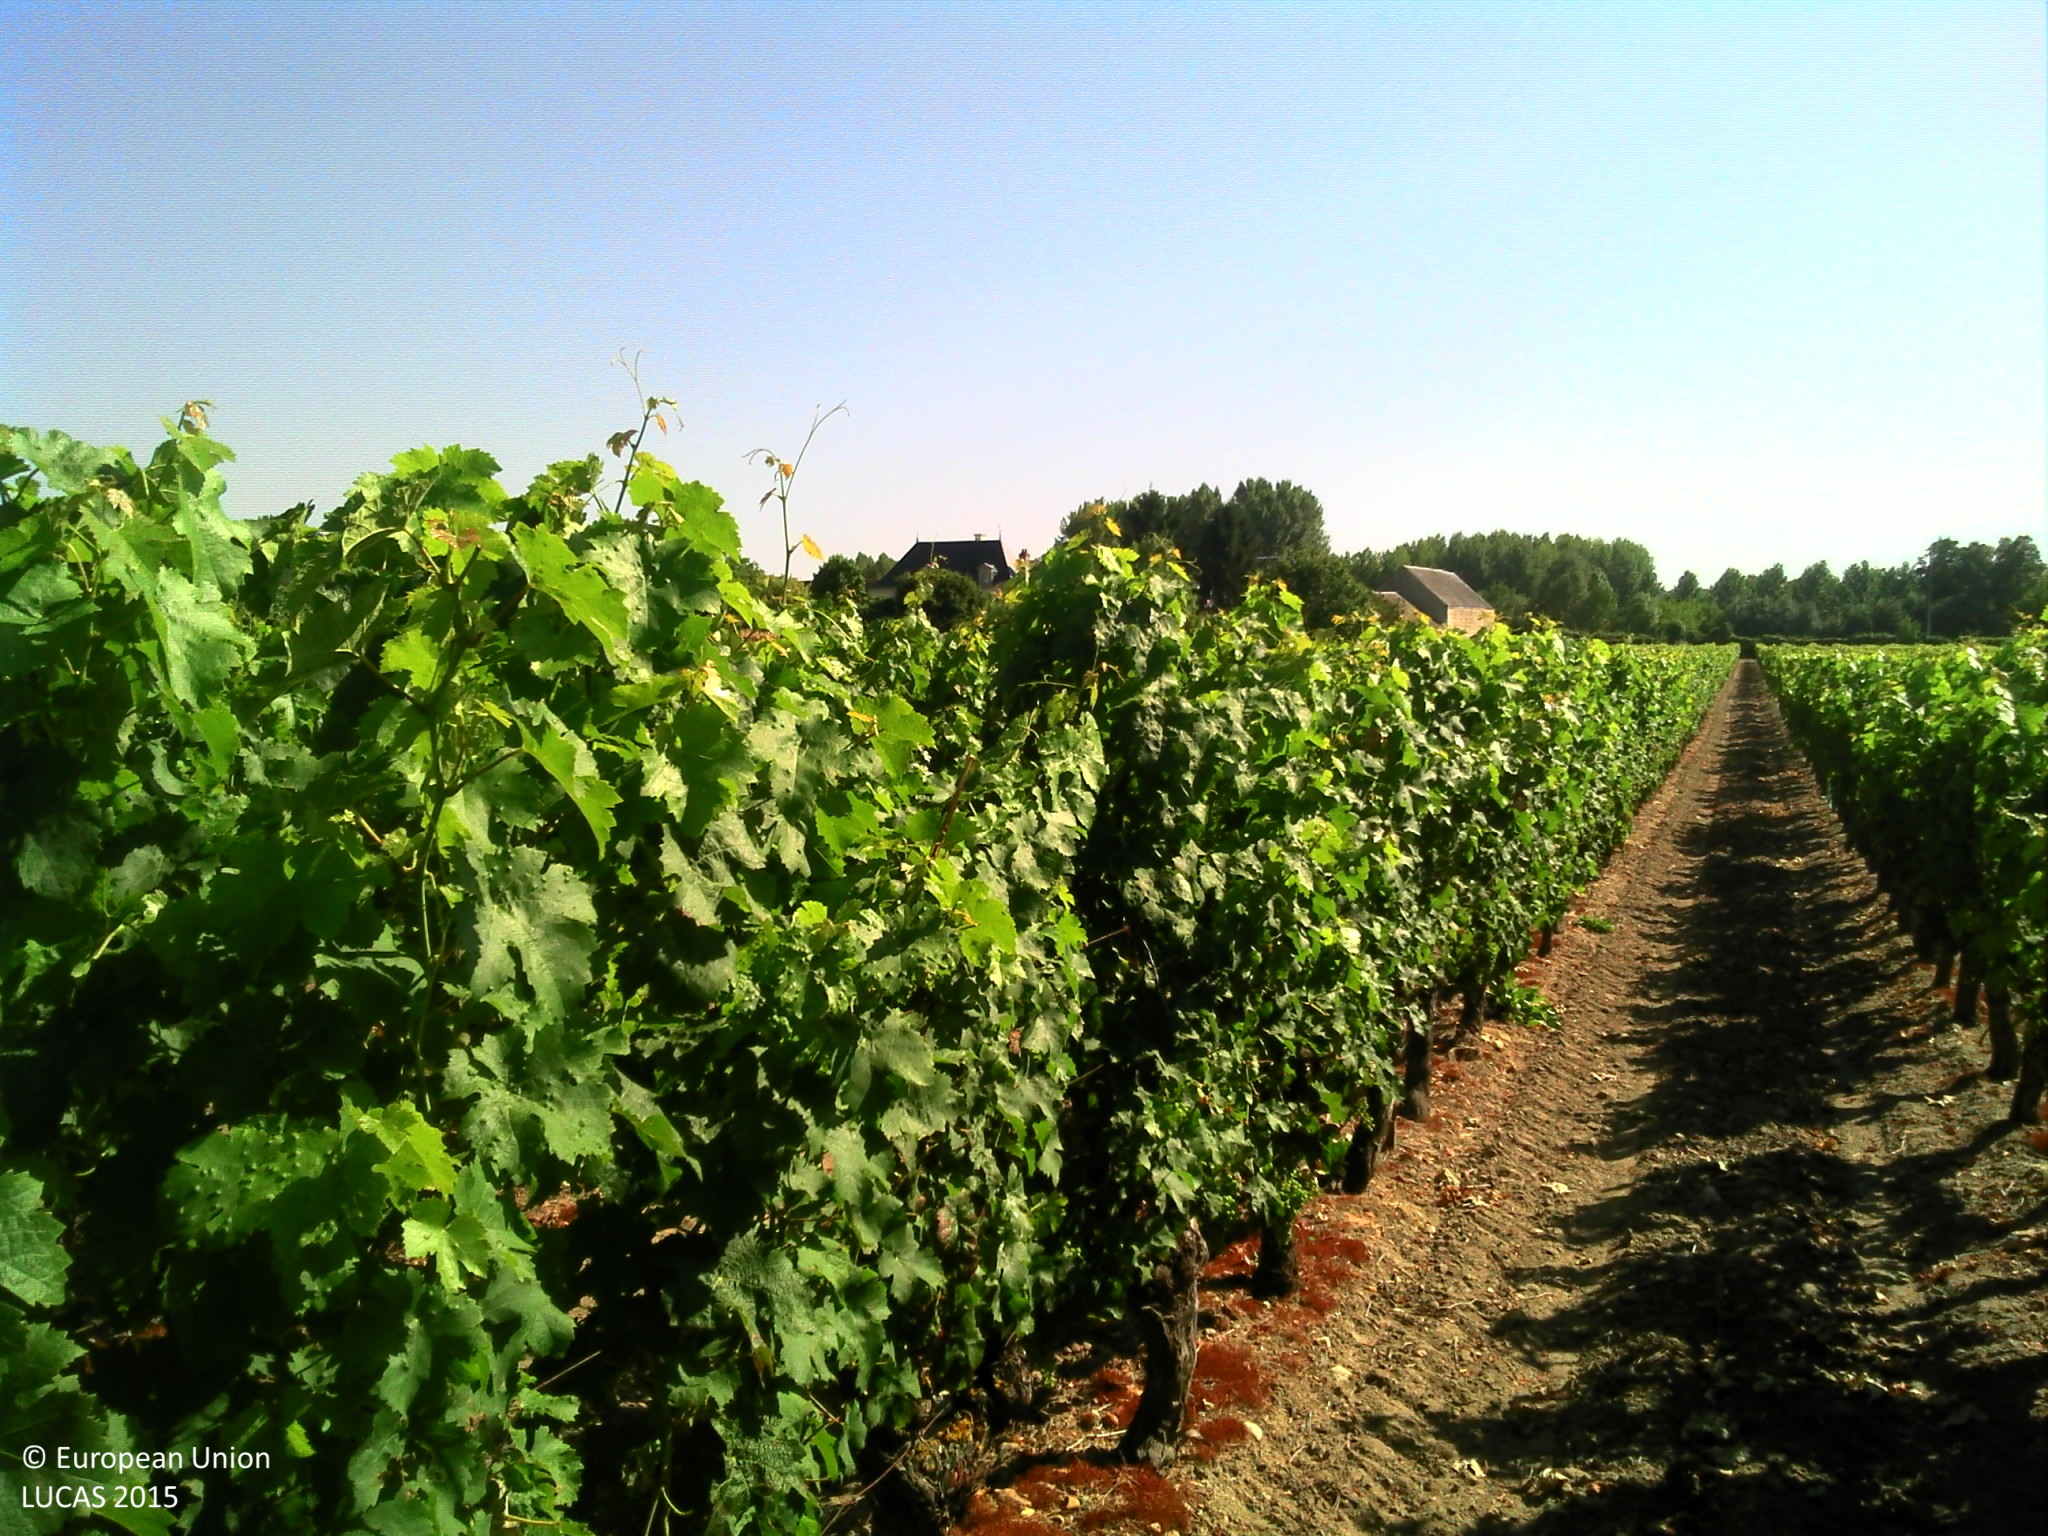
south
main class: Cropland
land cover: Vineyards
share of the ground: 50 - 75 %
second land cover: Other bare soil
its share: > 75 %
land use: Agriculture (excluding fallow land and kitchen gardens)
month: July
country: FR
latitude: 47.1851
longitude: 0.1718
